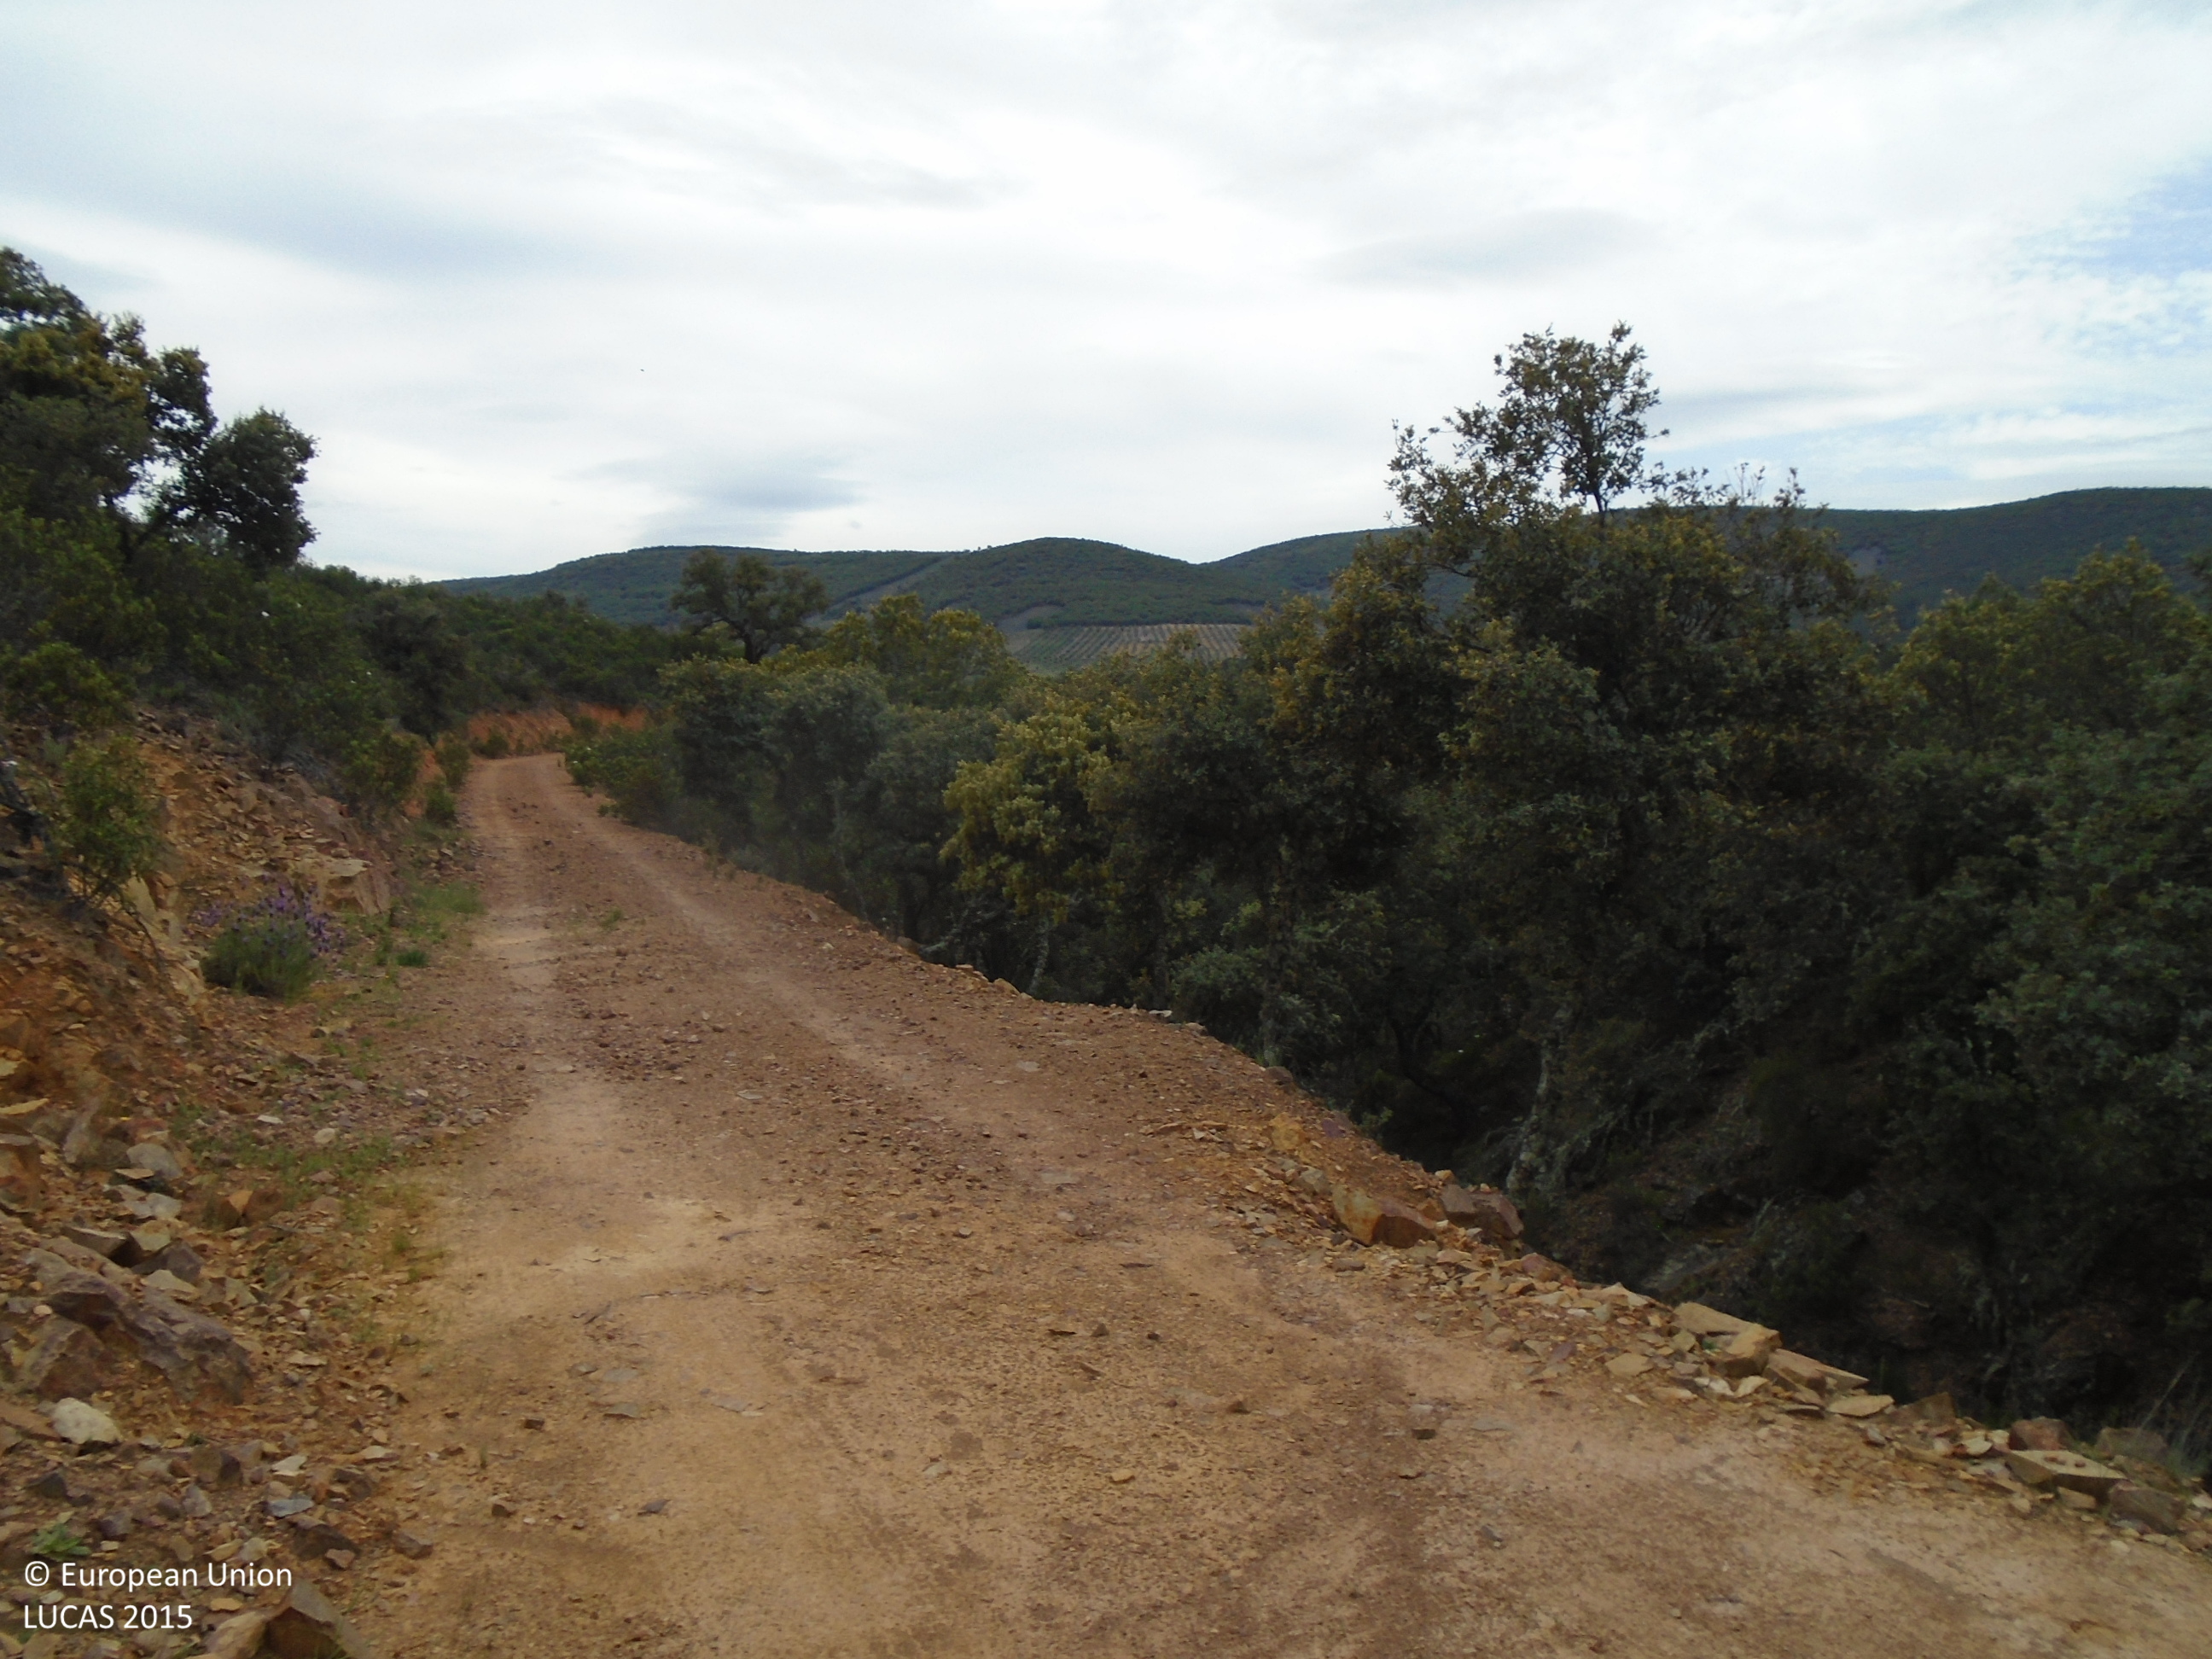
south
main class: Shrubland
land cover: Shrubland without tree cover
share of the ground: > 75 %
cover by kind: shrubs 95 %, consolidated bare surface 5 %
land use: Semi-natural and natural areas not in use
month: May
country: ES
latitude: 39.6508
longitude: -4.9270
